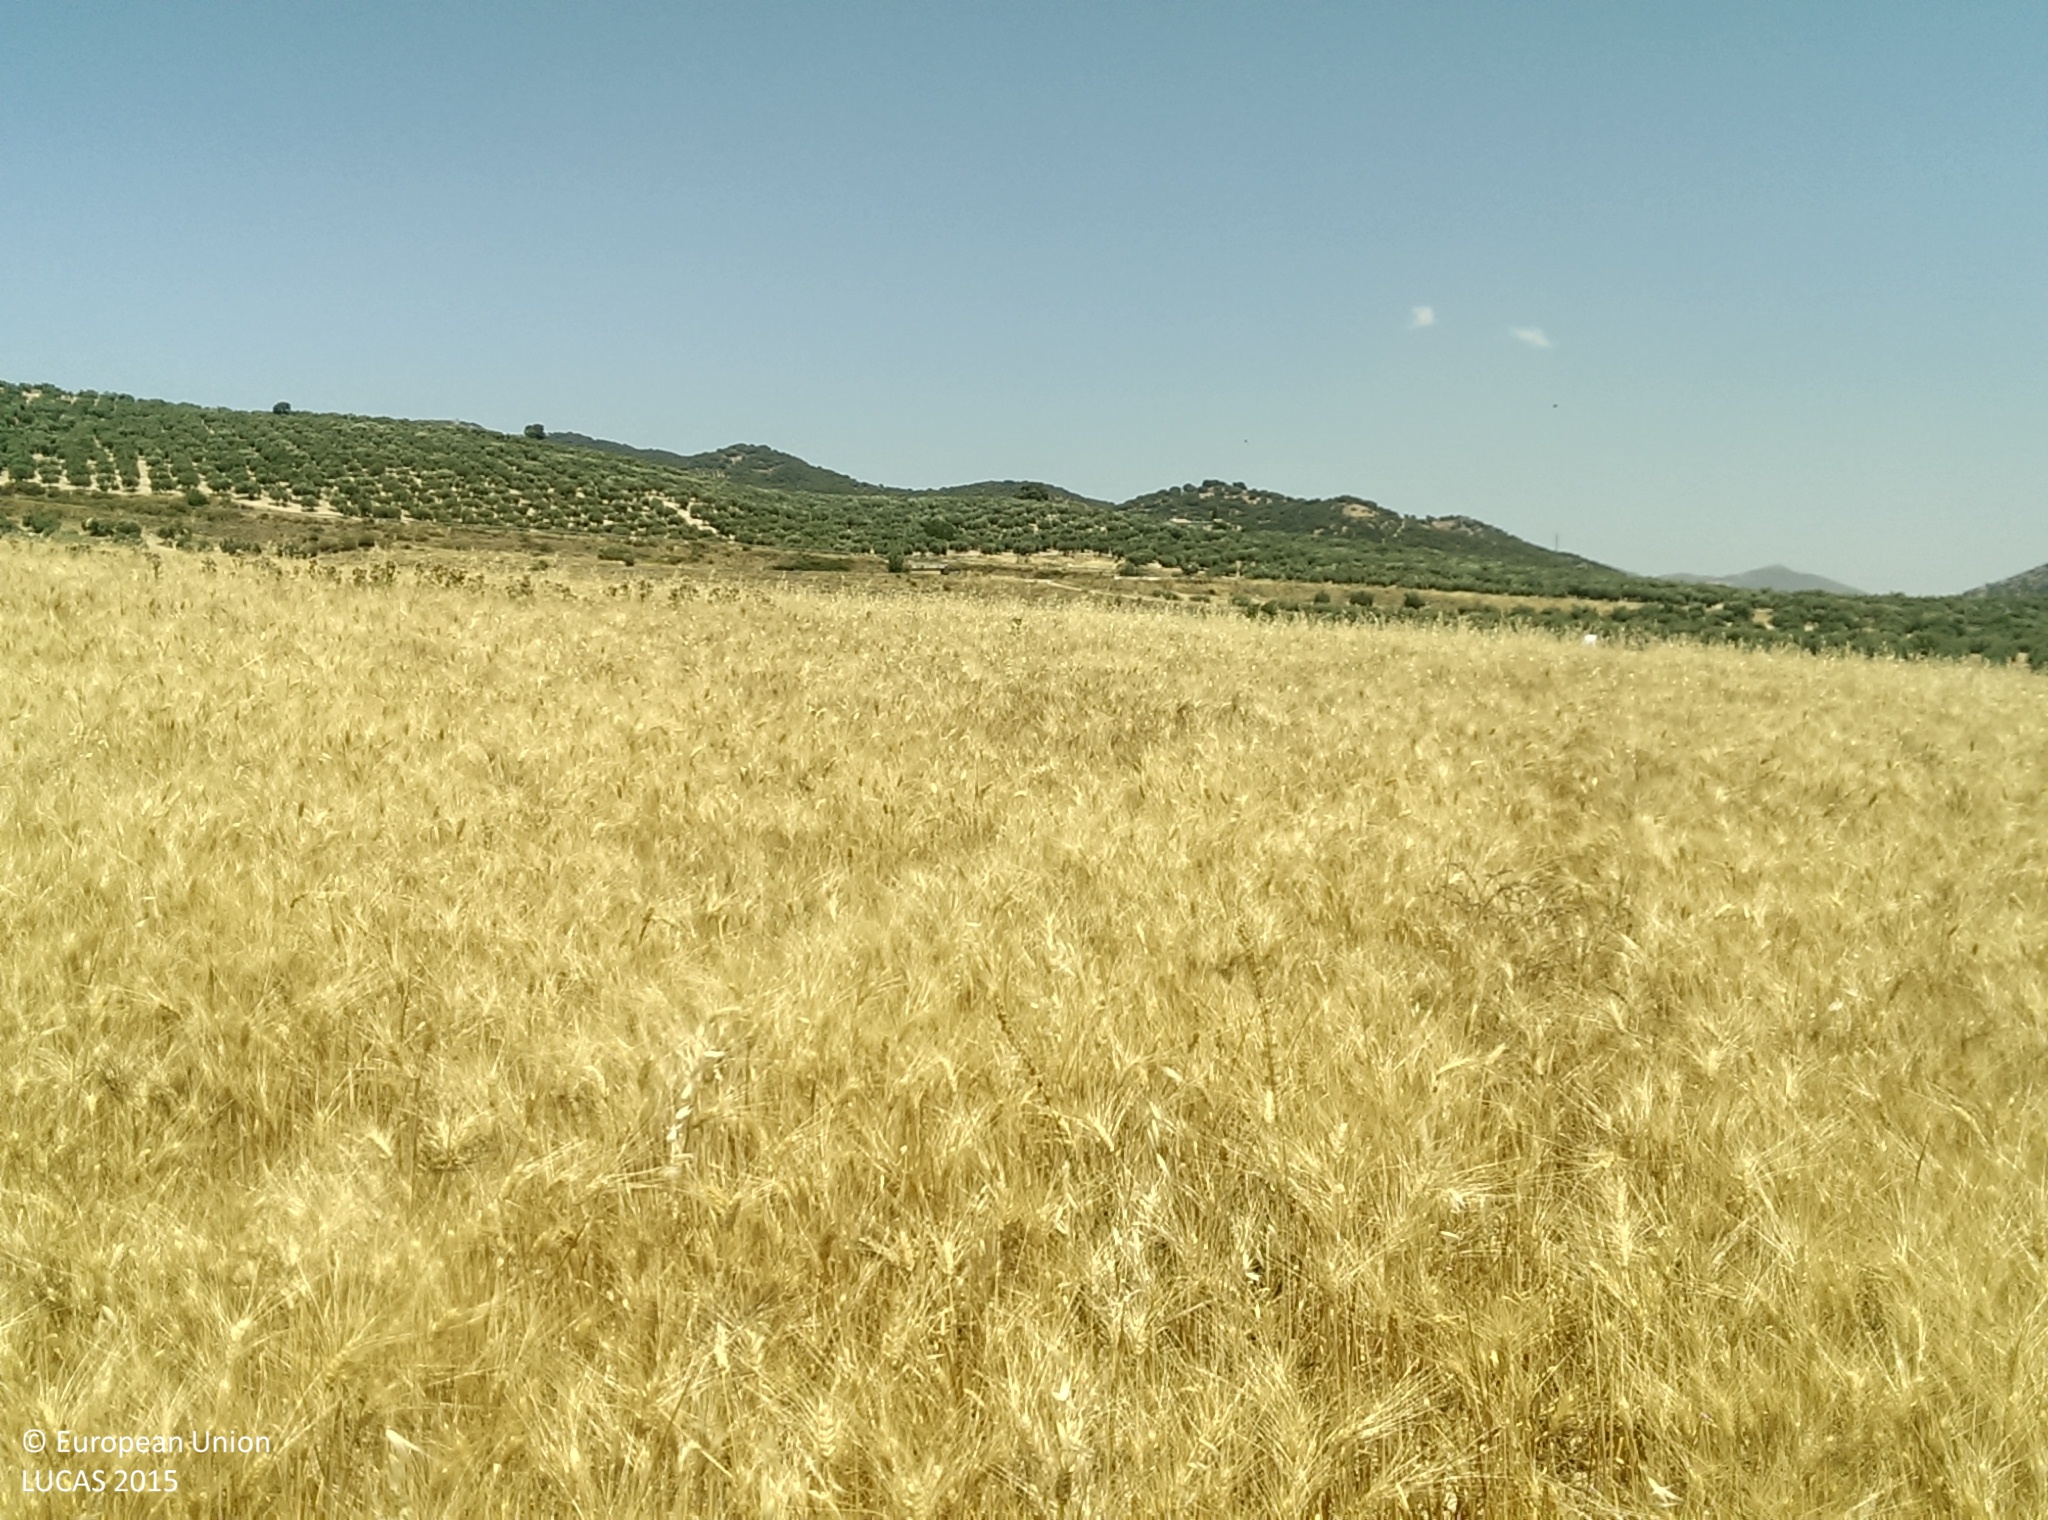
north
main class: Cropland
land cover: Common wheat
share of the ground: > 75 %
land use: Agriculture (excluding fallow land and kitchen gardens)
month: July
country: ES
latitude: 37.4235
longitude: -3.7468
